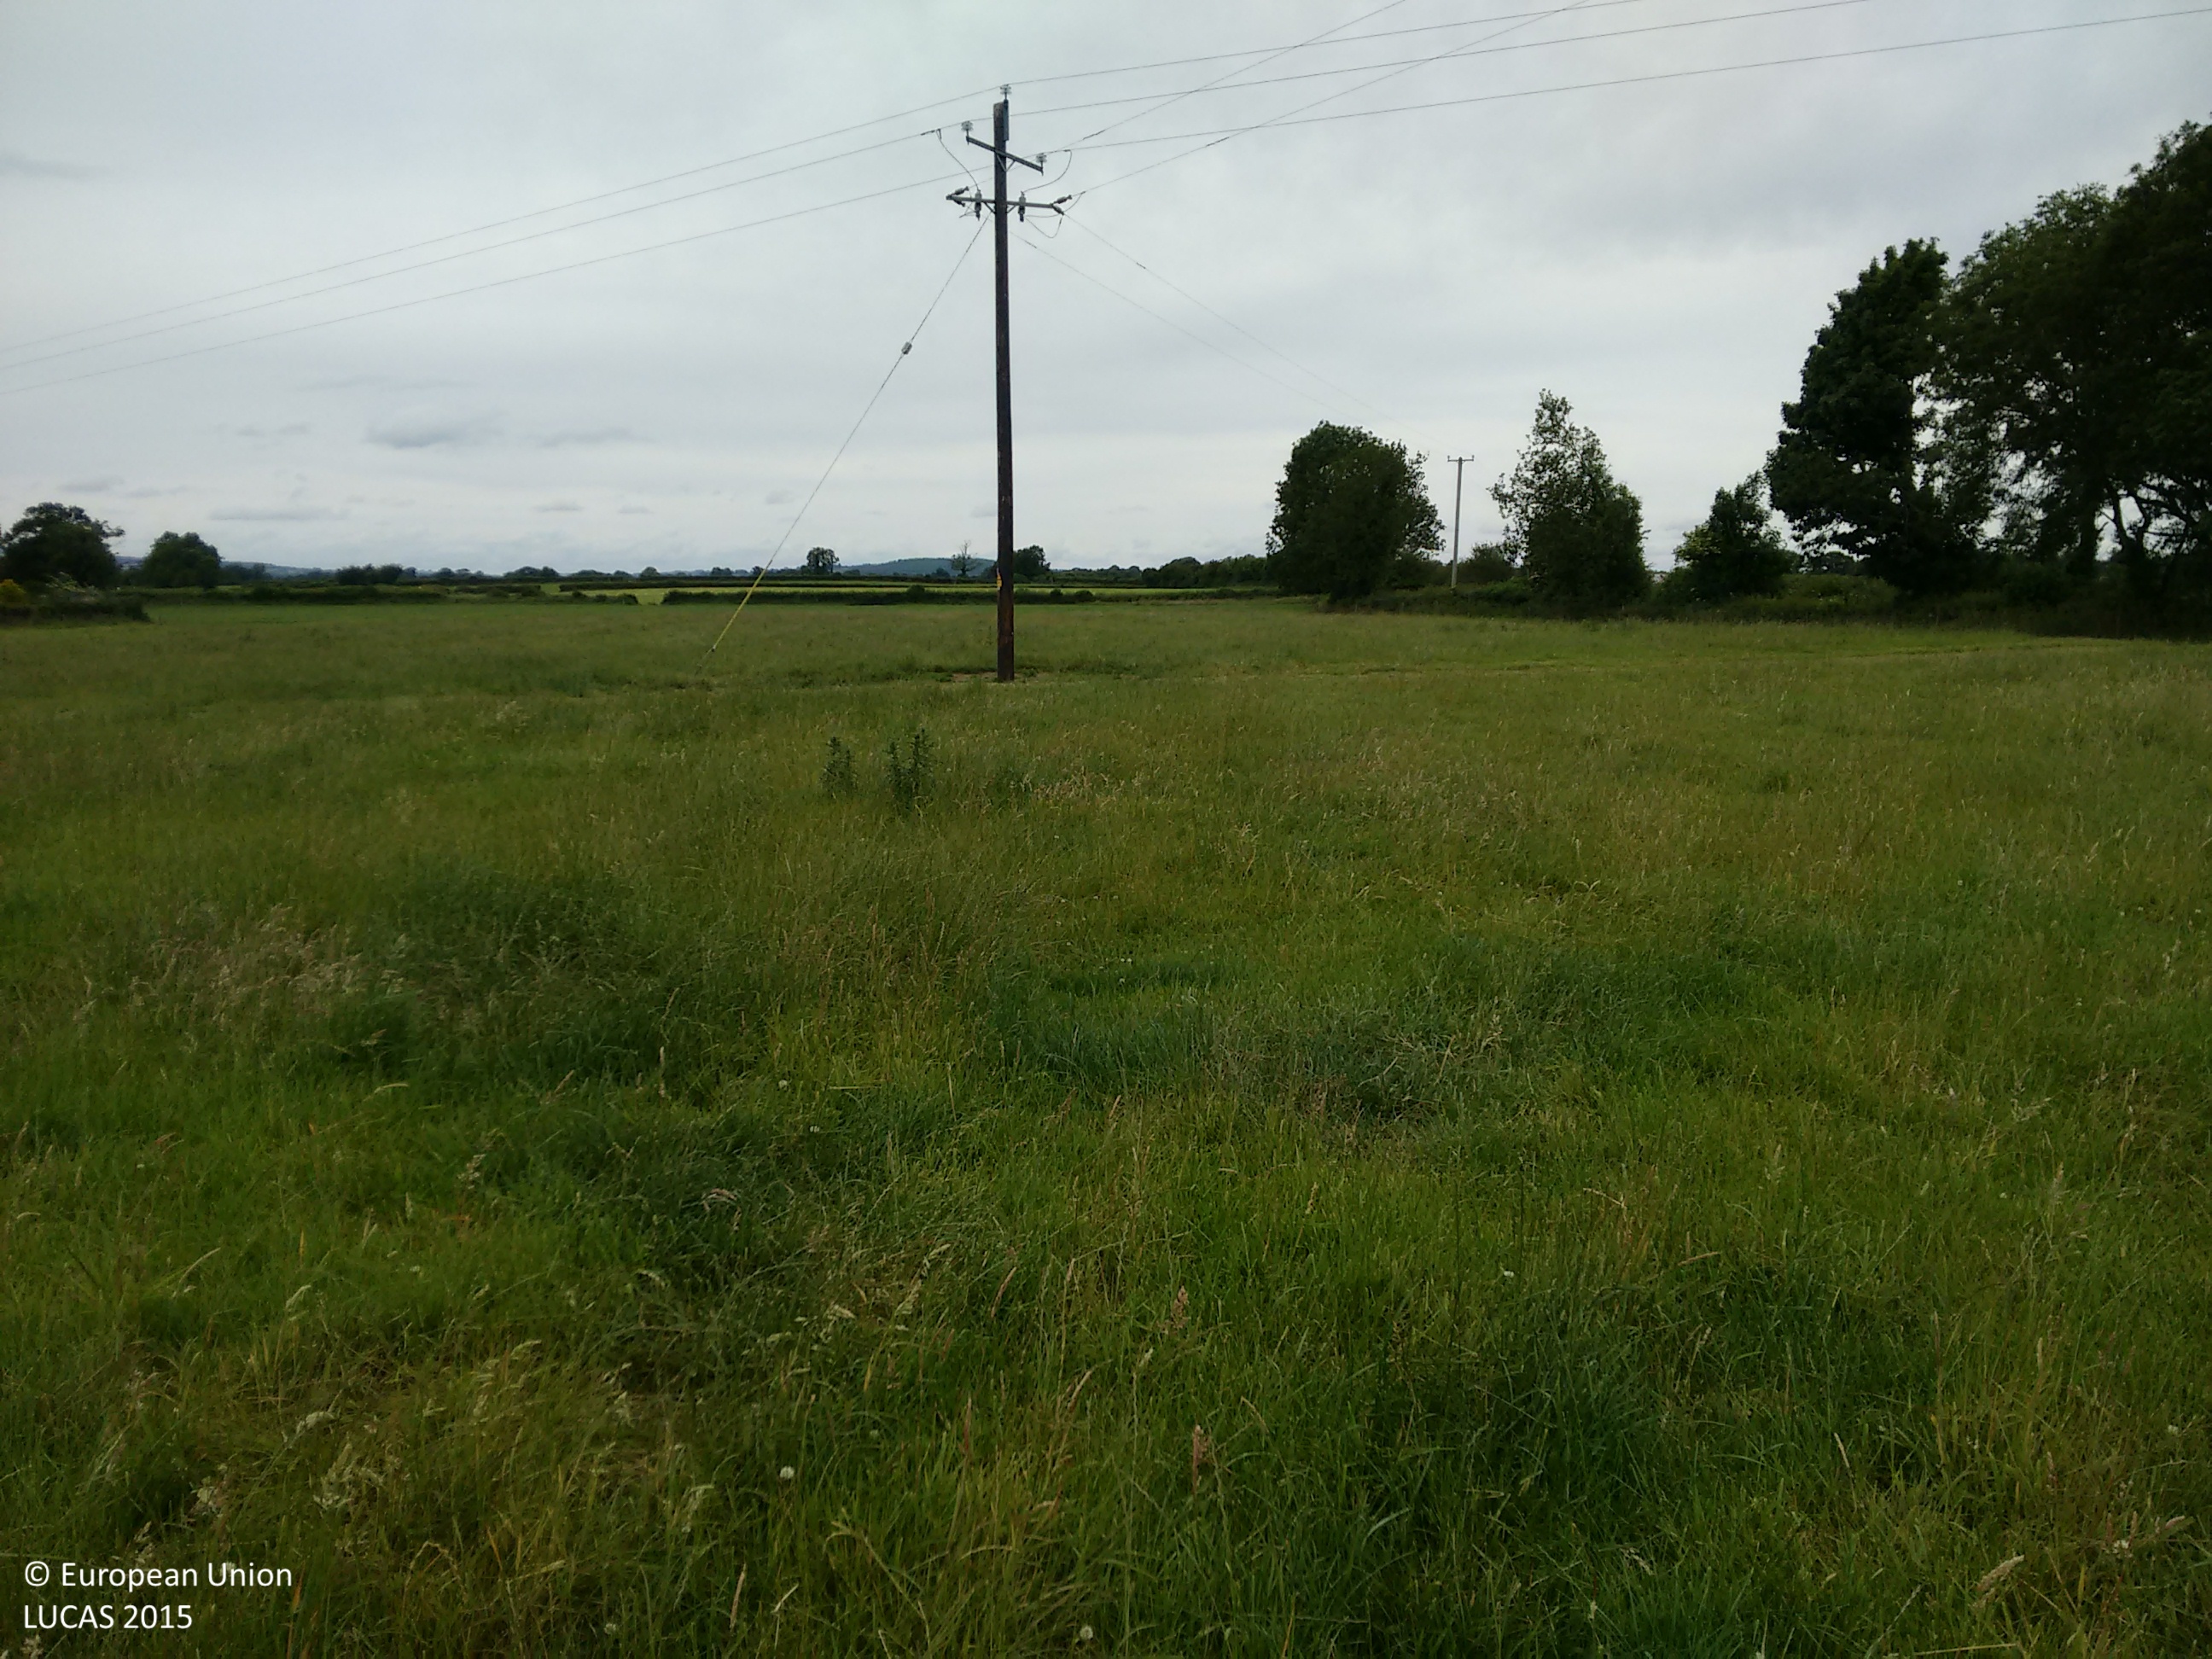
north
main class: Grassland
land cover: Grassland without tree/shrub cover
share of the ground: > 75 %
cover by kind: herbaceous plants 100 %
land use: Agriculture (excluding fallow land and kitchen gardens)
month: July
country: IE
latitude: 52.5518
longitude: -7.3961
